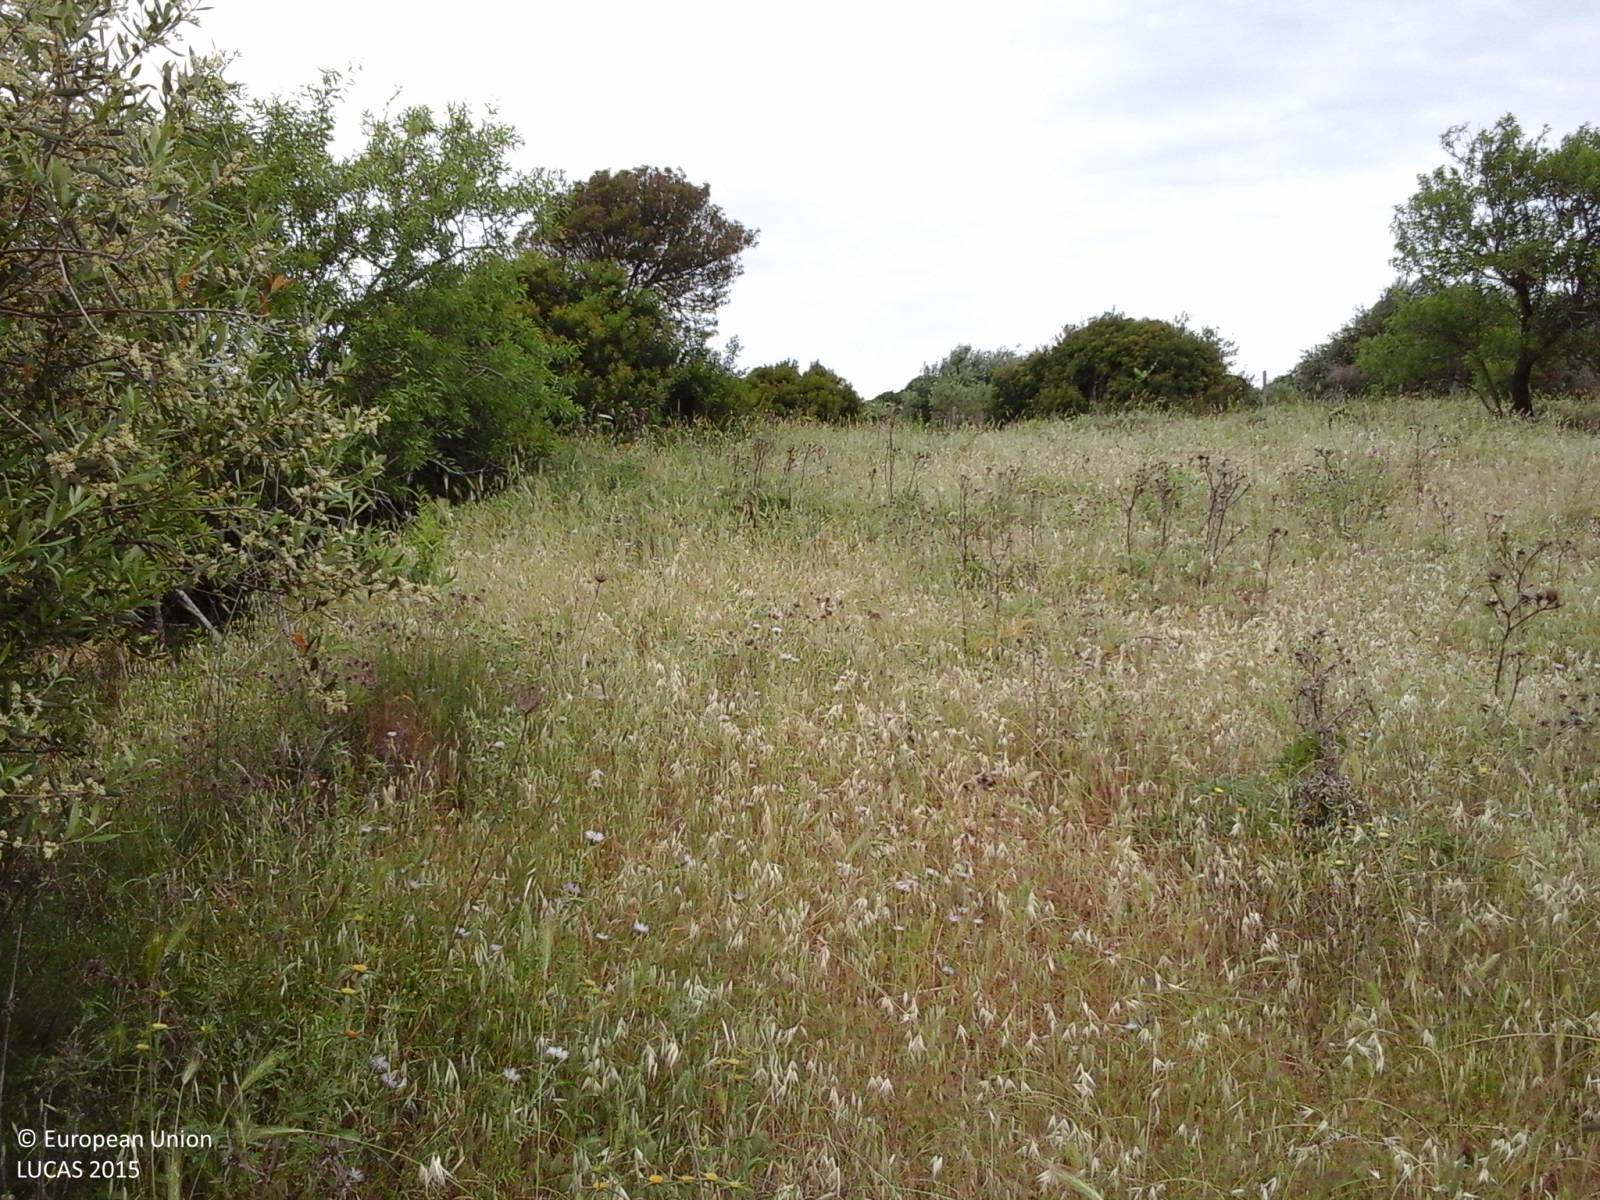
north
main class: Cropland
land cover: Dry pulses
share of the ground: 25 - 50 %
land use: Agriculture (excluding fallow land and kitchen gardens)
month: May
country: IT
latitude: 39.7346
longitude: 8.7818
